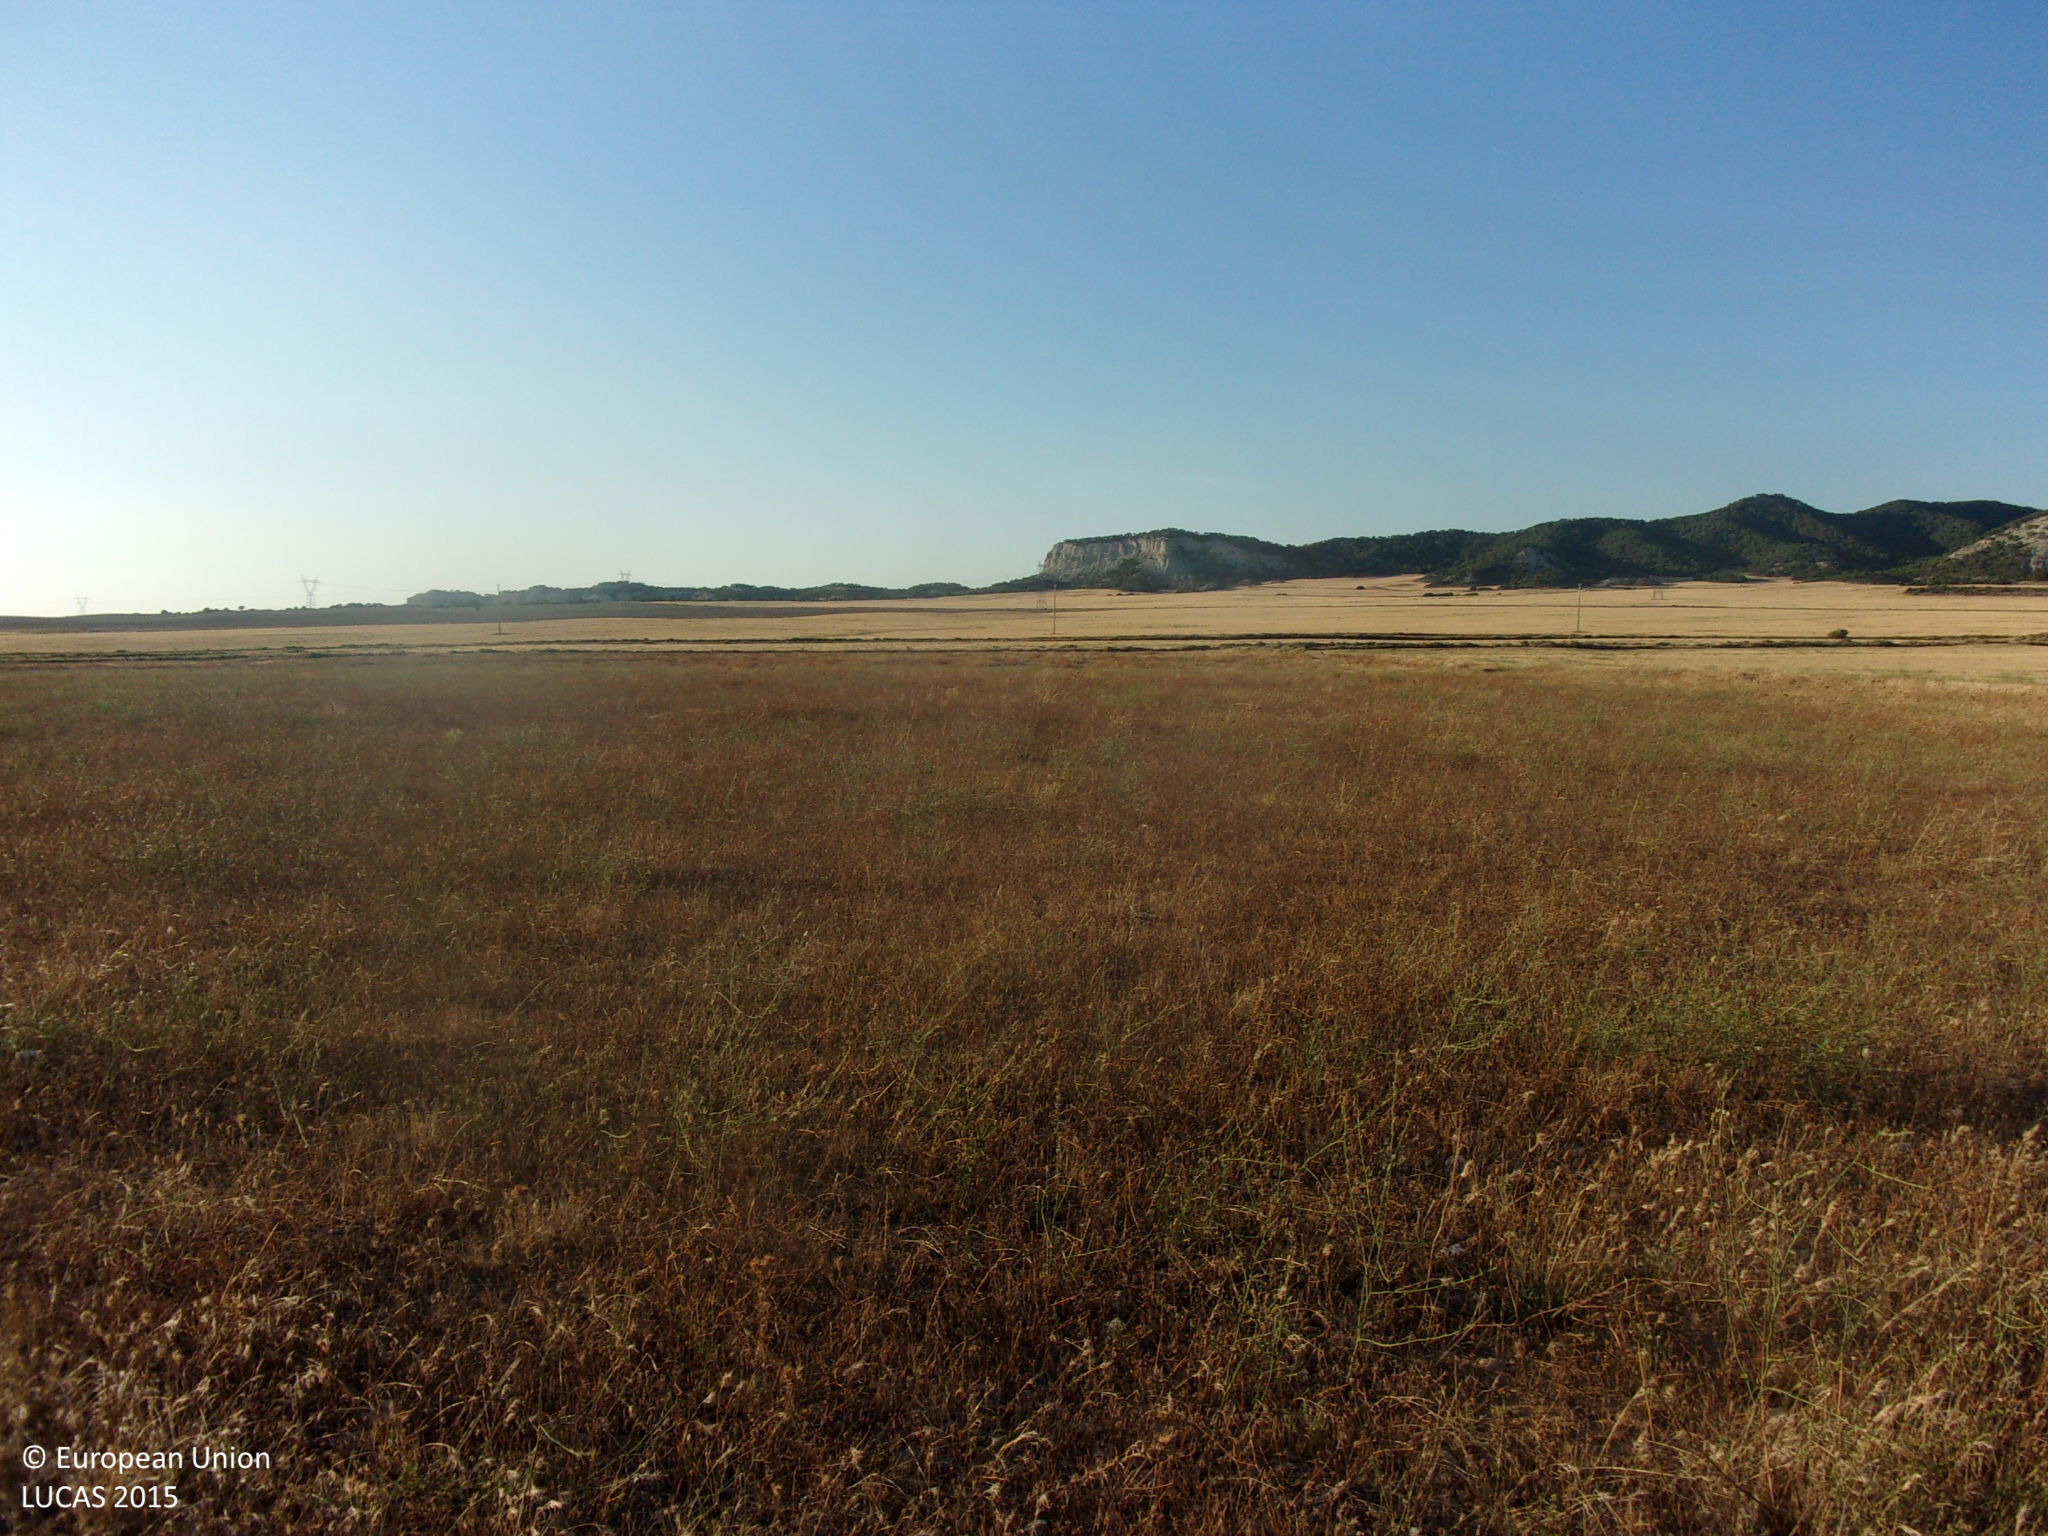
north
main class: Grassland
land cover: Spontaneously vegetated surfaces
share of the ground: > 75 %
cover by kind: herbaceous plants 100 %
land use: Fallow land
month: July
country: ES
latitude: 41.9753
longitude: -1.0442
